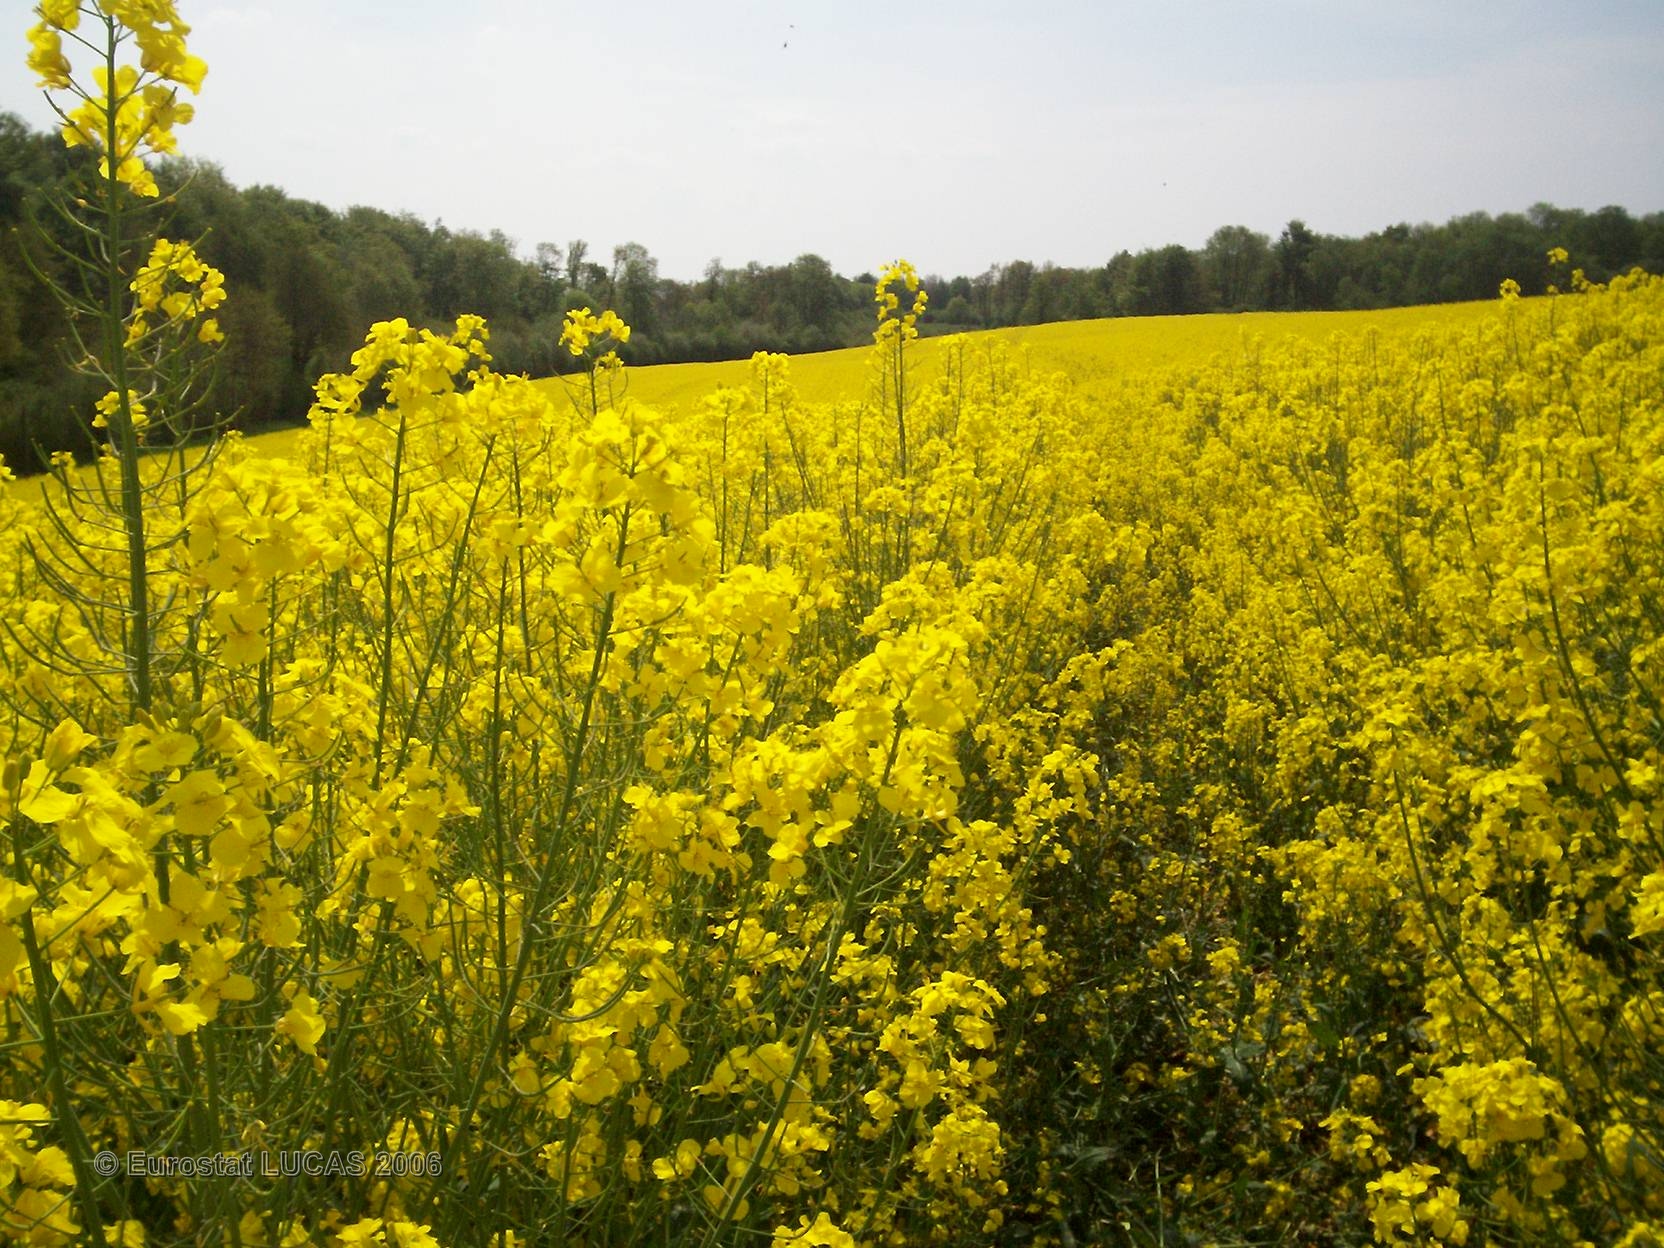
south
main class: Cropland
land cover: Rape and turnip rape
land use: Agriculture (excluding fallow land and kitchen gardens)
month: May
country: FR
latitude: 49.2287
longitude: 0.5402
